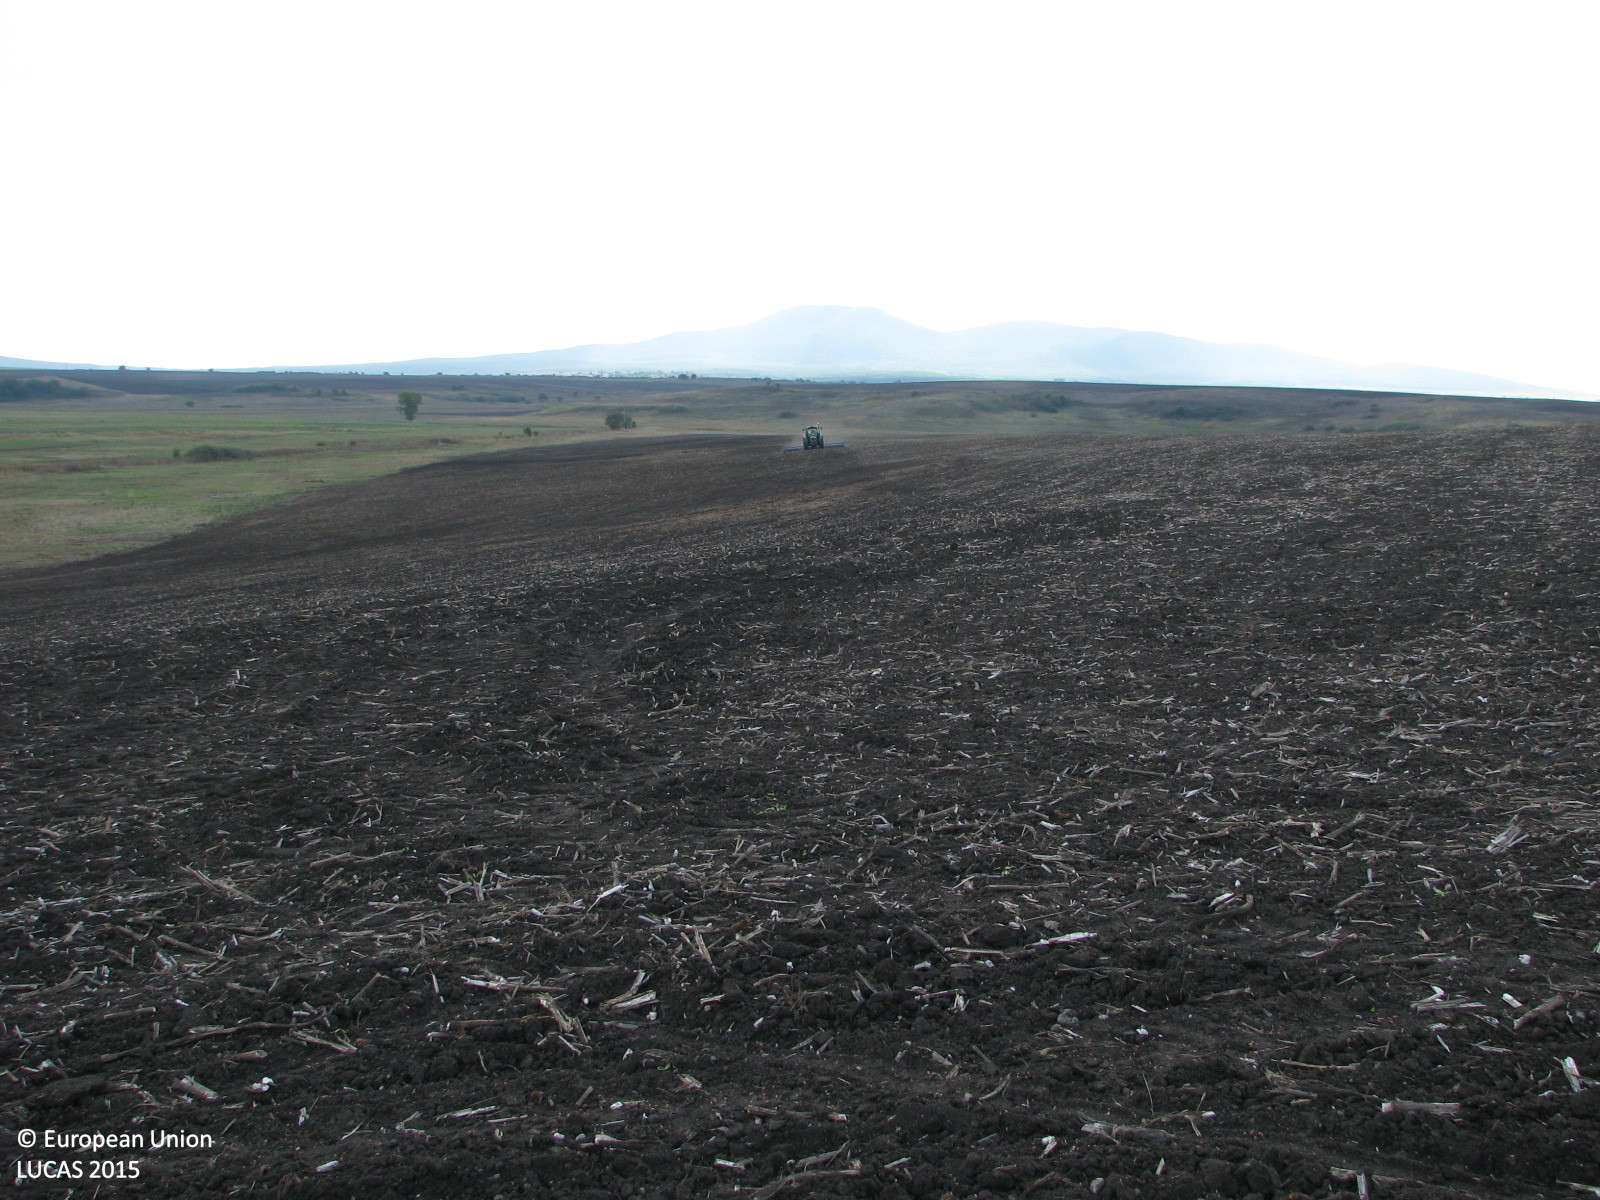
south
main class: Cropland
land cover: Sunflower
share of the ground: < 10 %
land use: Agriculture (excluding fallow land and kitchen gardens)
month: October
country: BG
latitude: 42.2934
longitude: 26.3259
